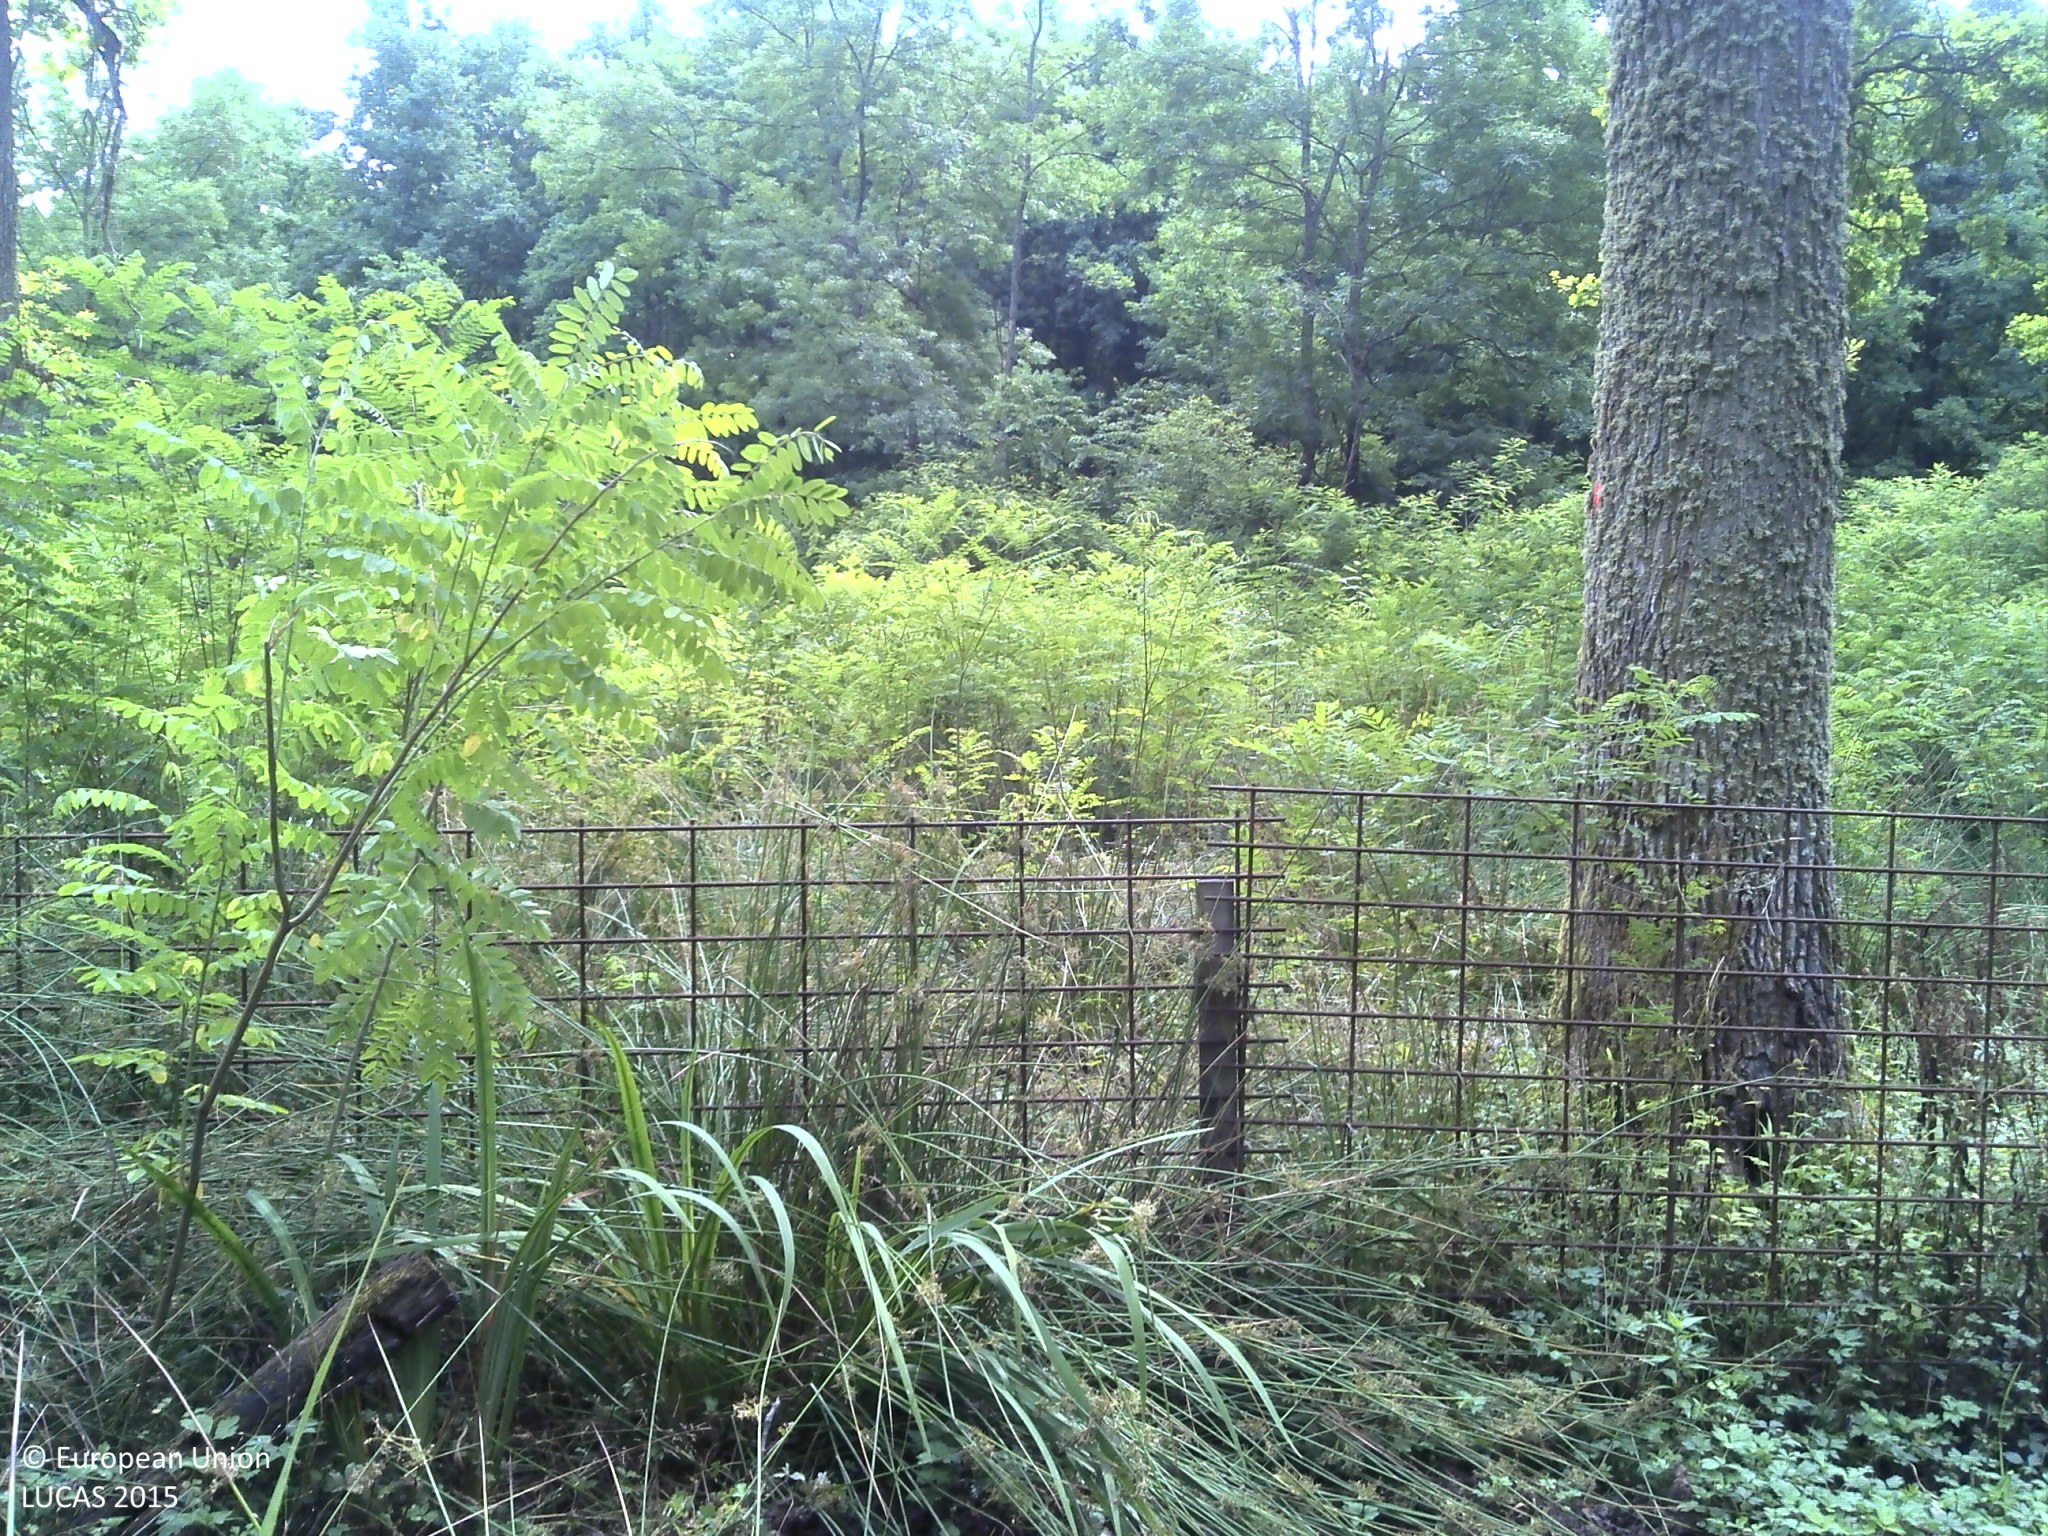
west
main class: Woodland
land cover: Broadleaved woodland
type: acidophilous oak and oak-birch forest
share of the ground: > 75 %
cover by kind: broadleaved forest trees 100 %
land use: Forestry
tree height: > 5 m
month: June
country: HR
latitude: 45.1745
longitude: 17.3673
